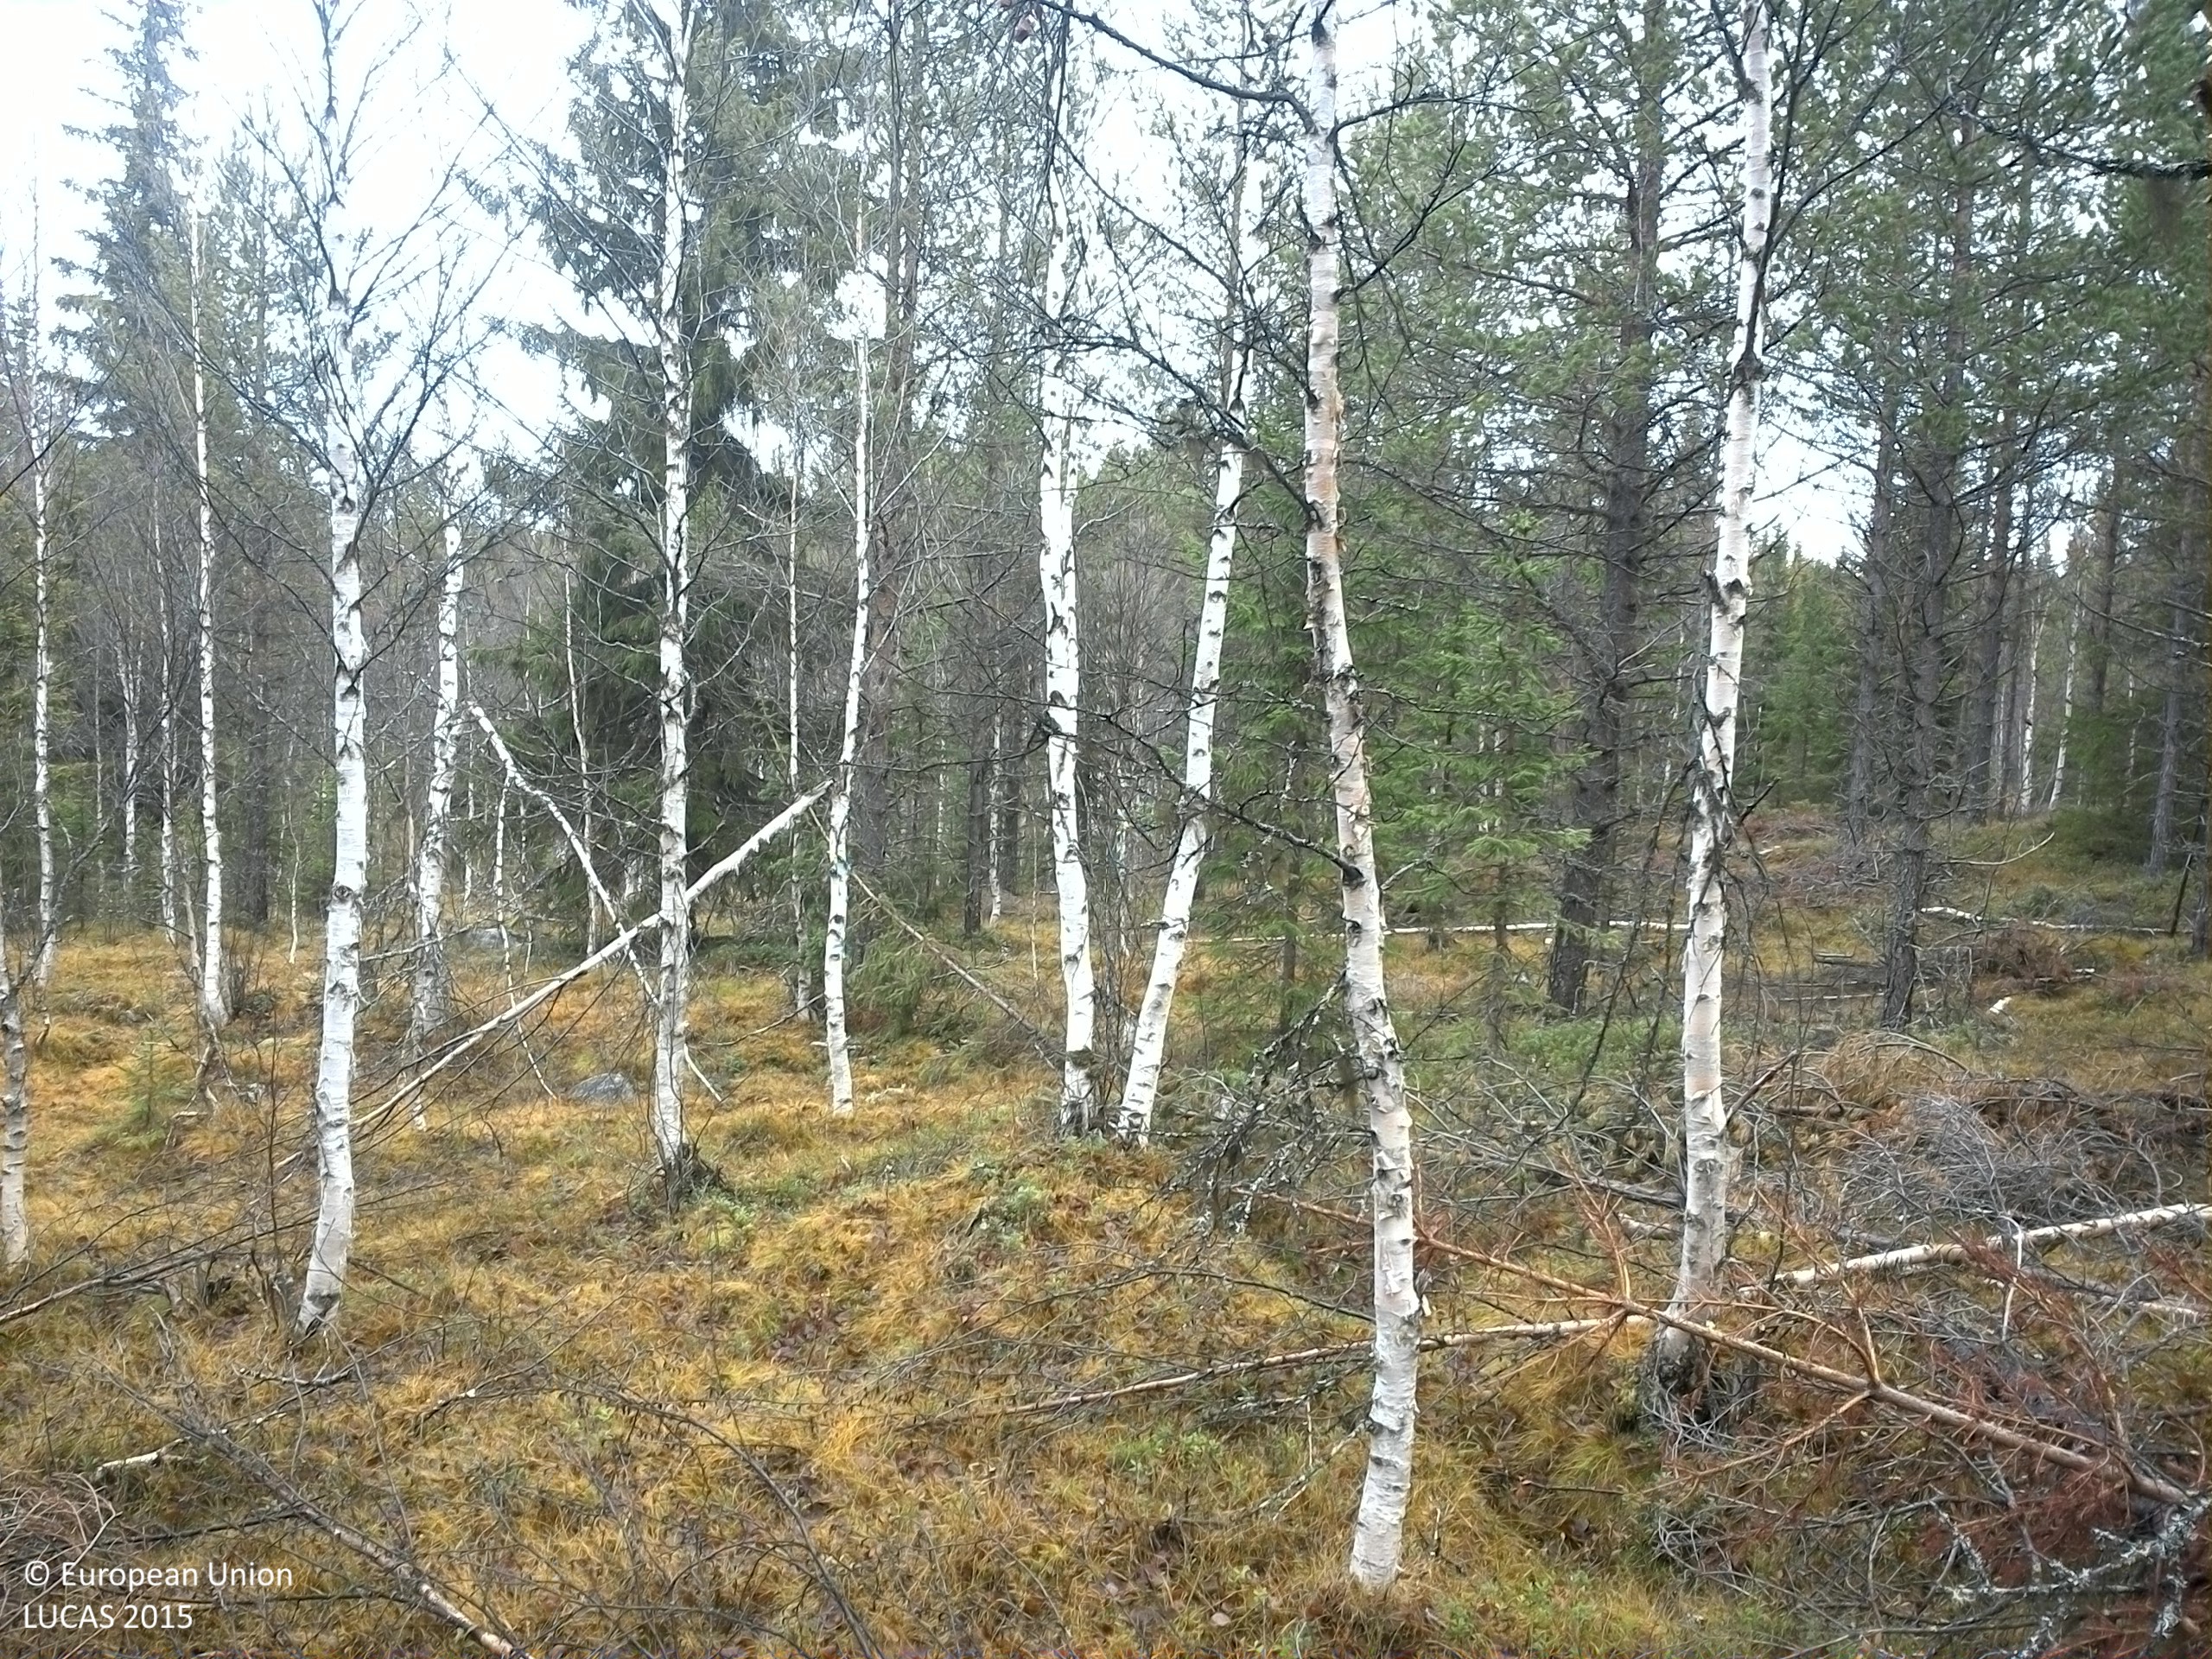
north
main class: Woodland
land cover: Pine dominated mixed woodland
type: boreal forest
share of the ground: 50 - 75 %
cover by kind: coniferous forest trees 35 %, shrubs 20 %, broadleaved forest trees 15 %, herbaceous plants 15 %, lichens and mosses 15 %
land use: Forestry
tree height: > 5 m
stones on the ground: 25 - 50 %
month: October
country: SE
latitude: 63.9144
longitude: 15.2124
